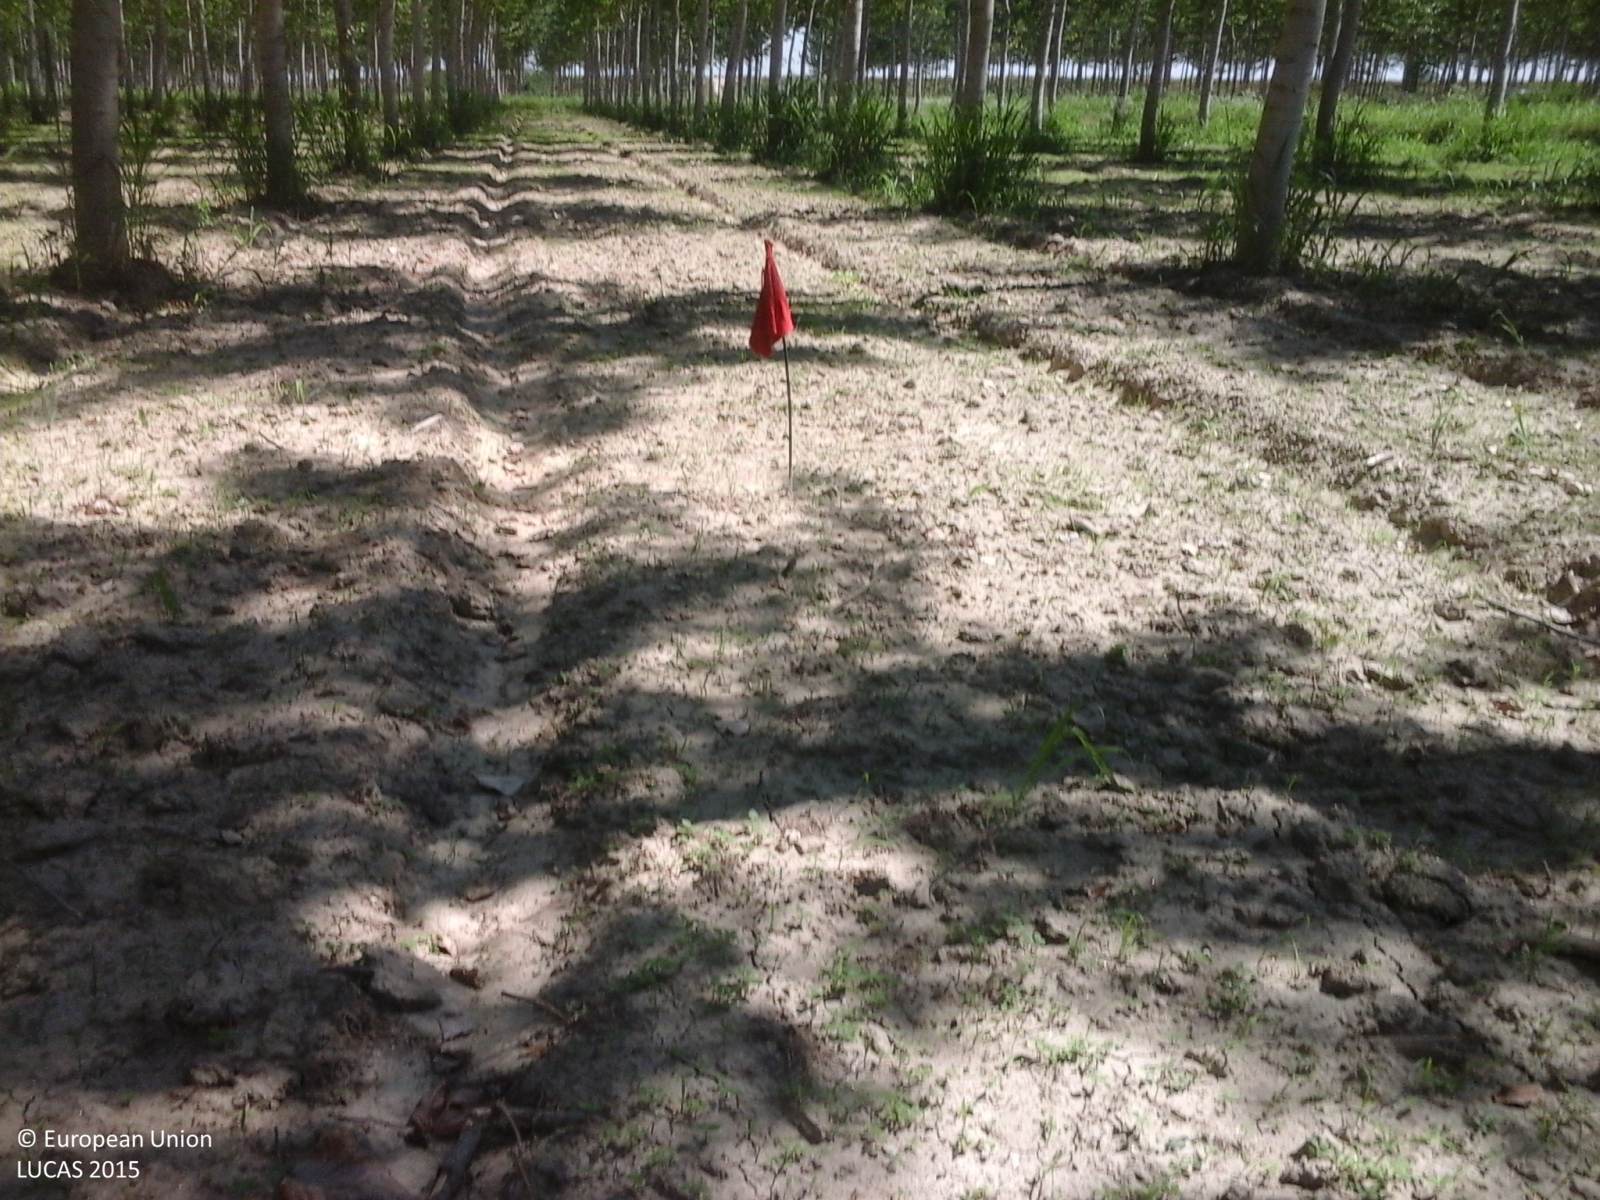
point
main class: Woodland
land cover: Broadleaved woodland
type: non-riverine alder, birch or aspen forest
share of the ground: > 75 %
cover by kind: broadleaved forest trees 85 %, unconsolidated bare surface 15 %
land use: Forestry
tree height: > 5 m
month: June
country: IT
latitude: 45.0450
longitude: 8.6441
